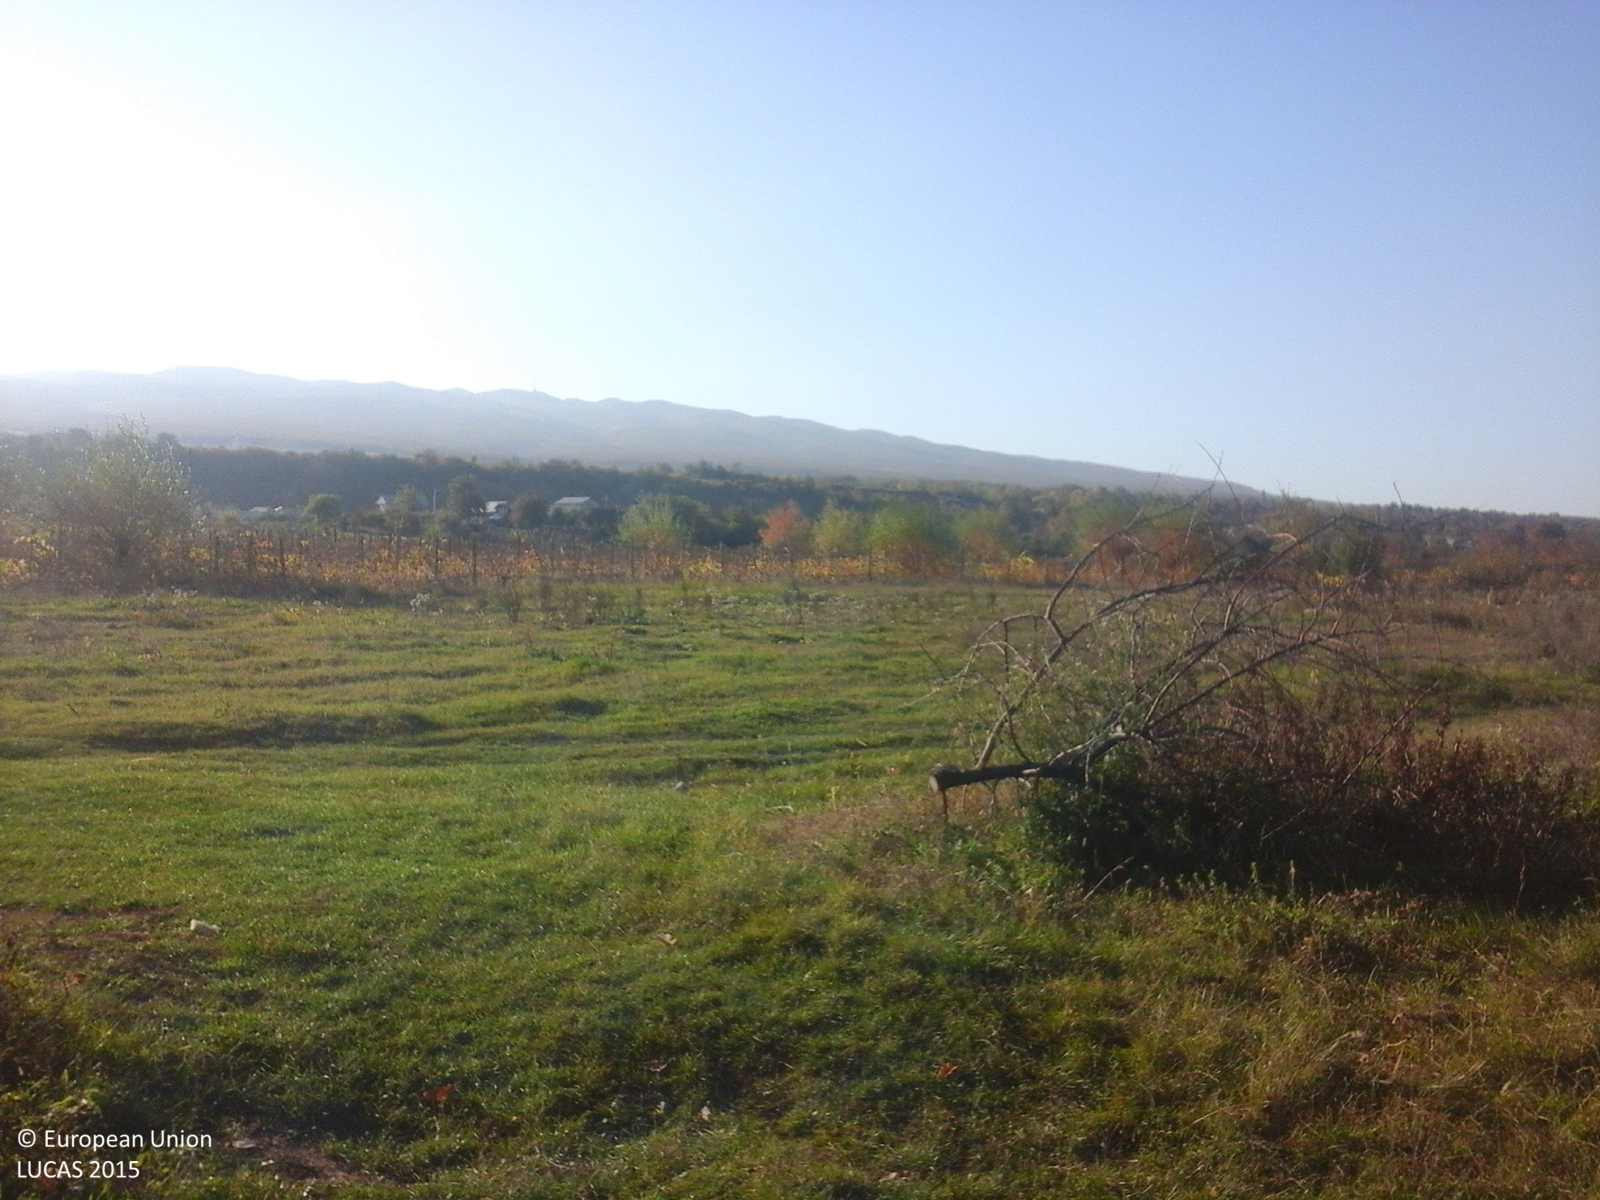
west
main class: Cropland
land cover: Maize
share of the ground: > 75 %
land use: Agriculture (excluding fallow land and kitchen gardens)
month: October
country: RO
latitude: 45.8517
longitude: 27.0528
